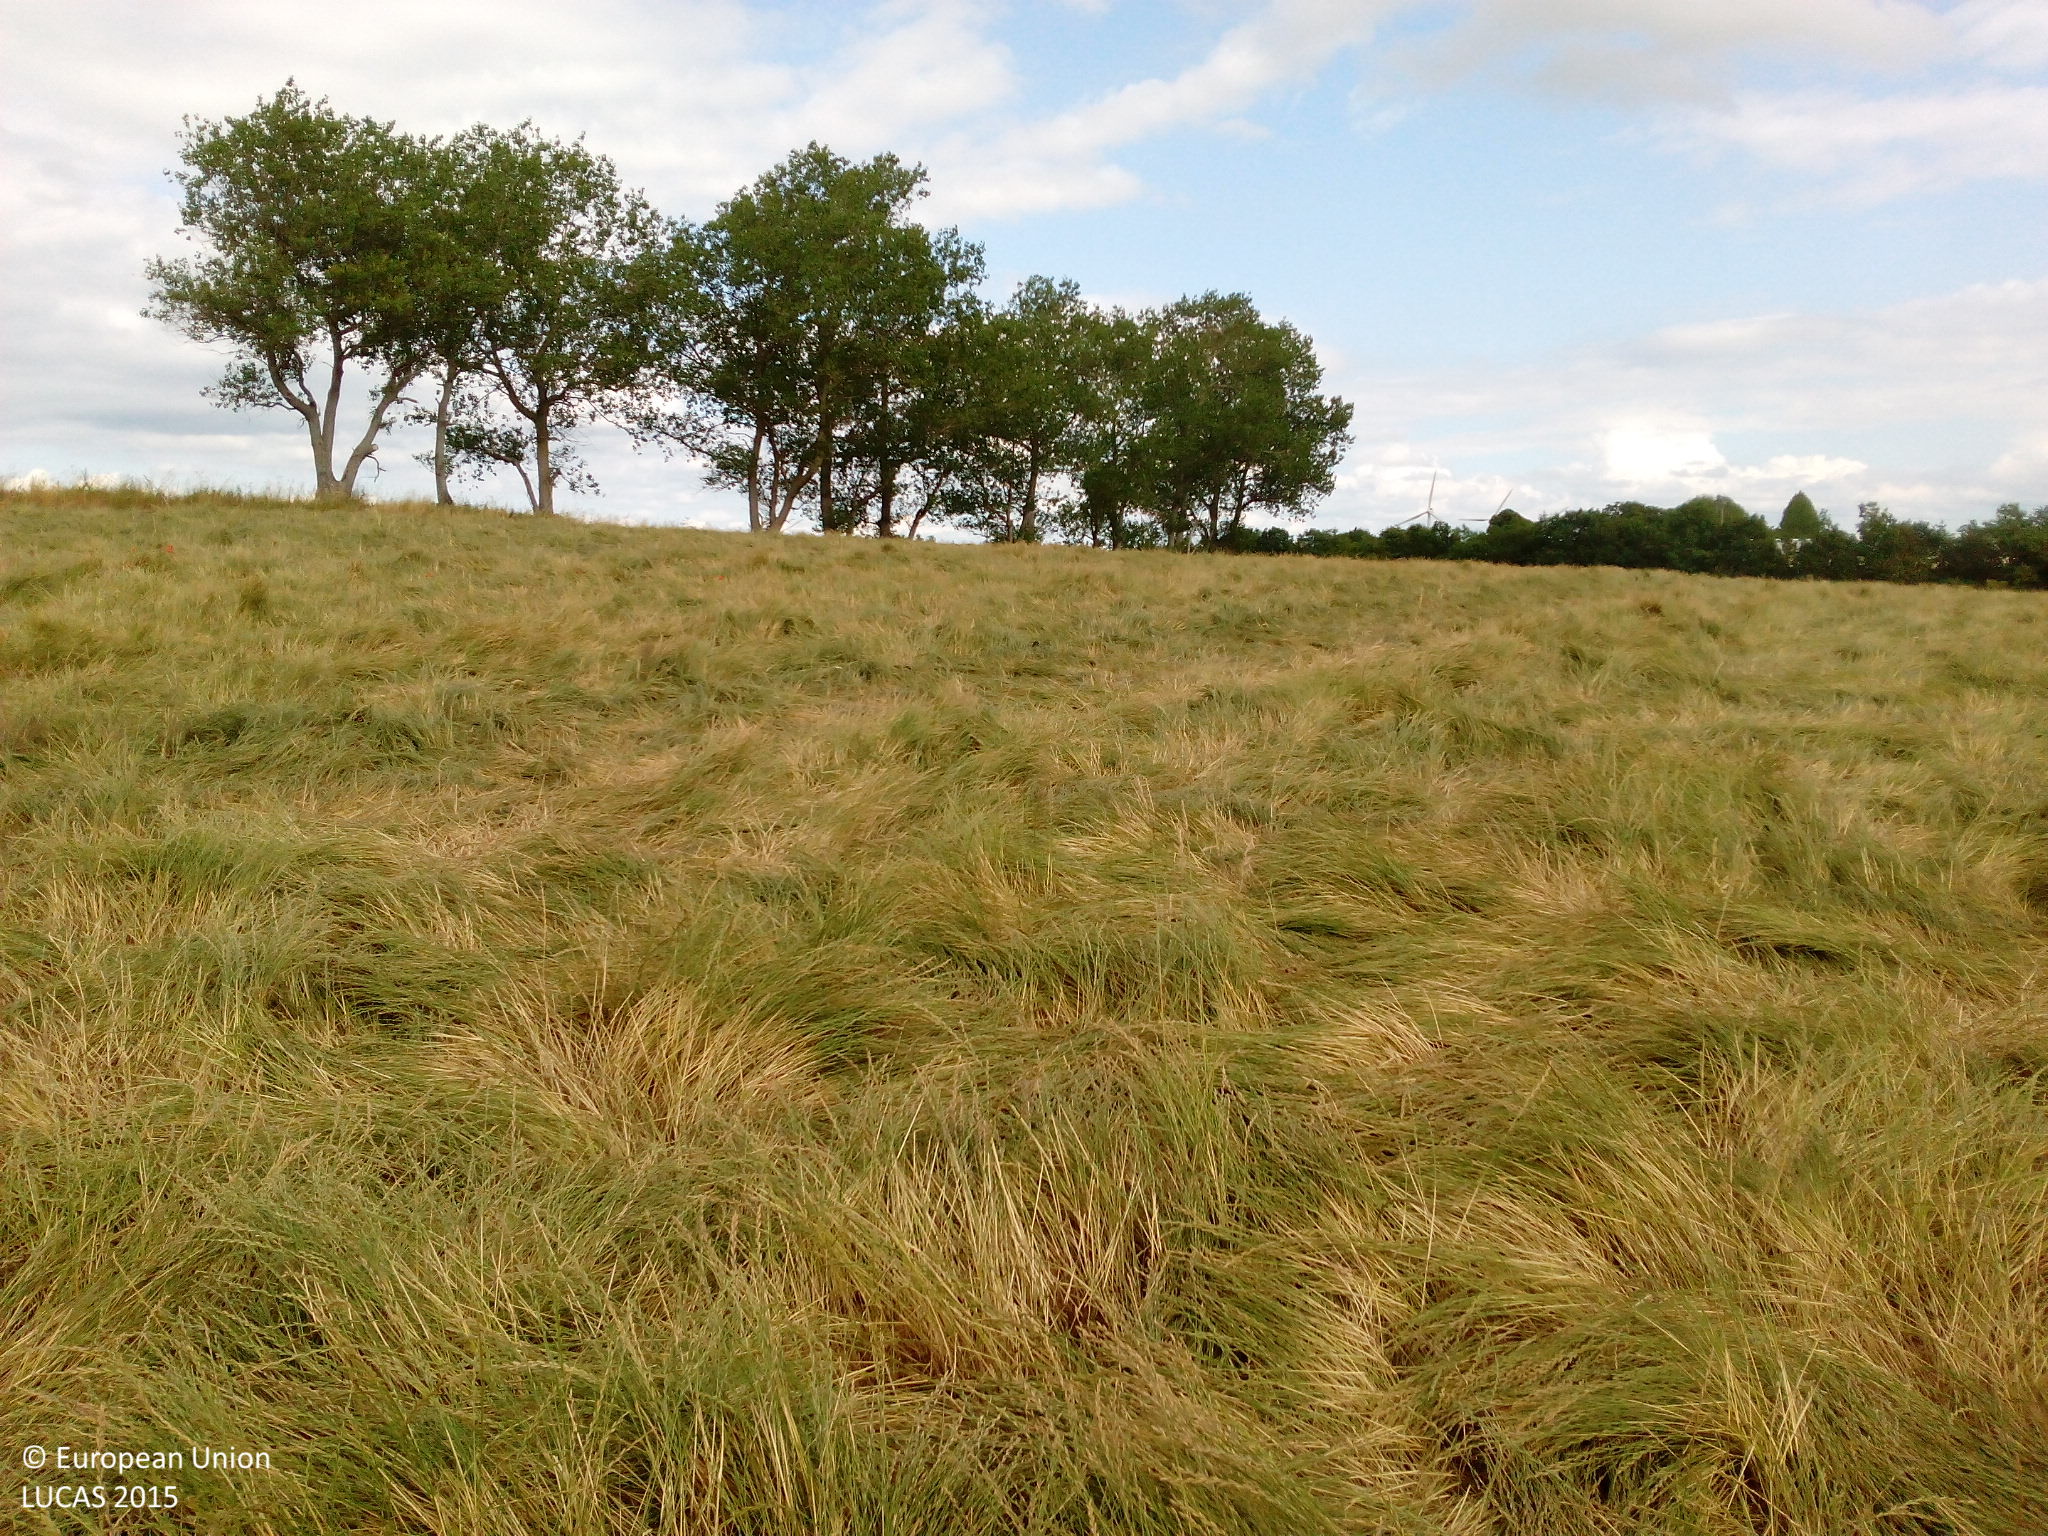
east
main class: Cropland
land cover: Temporary grasslands
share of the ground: > 75 %
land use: Agriculture (excluding fallow land and kitchen gardens)
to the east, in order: Temporary grasslands; Grass margins; Broadleaved woodland; Barley; Abandoned hedges; Spontaneously vegetated surfaces; Temporary grasslands
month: July
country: DK
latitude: 55.3368
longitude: 11.2444
